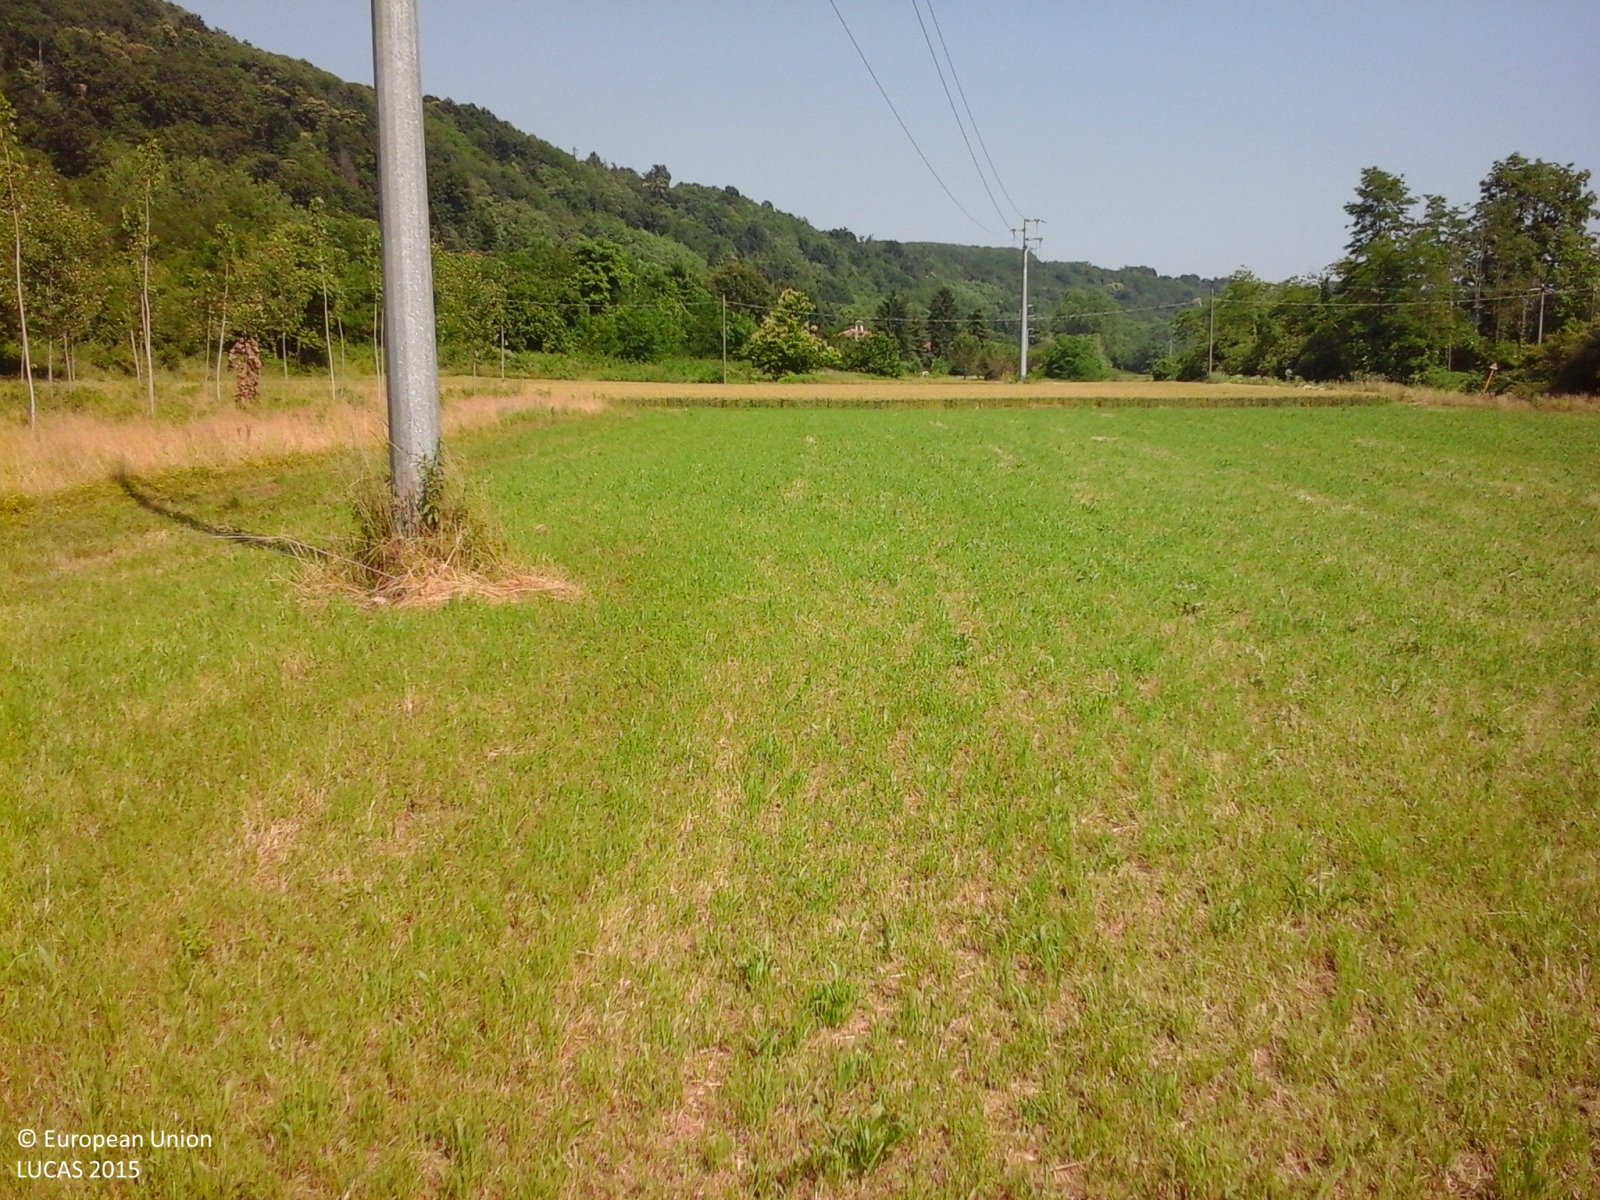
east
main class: Grassland
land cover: Grassland without tree/shrub cover
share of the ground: > 75 %
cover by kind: herbaceous plants 100 %
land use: Agriculture (excluding fallow land and kitchen gardens)
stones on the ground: < 10 %
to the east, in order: Grassland without tree/shrub cover; Electric lines; Broadleaved woodland; Common wheat; Tracks; Broadleaved woodland; Other bare soil; Broadleaved woodland; Tracks; Broadleaved woodland
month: June
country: IT
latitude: 45.3768
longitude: 7.9729
